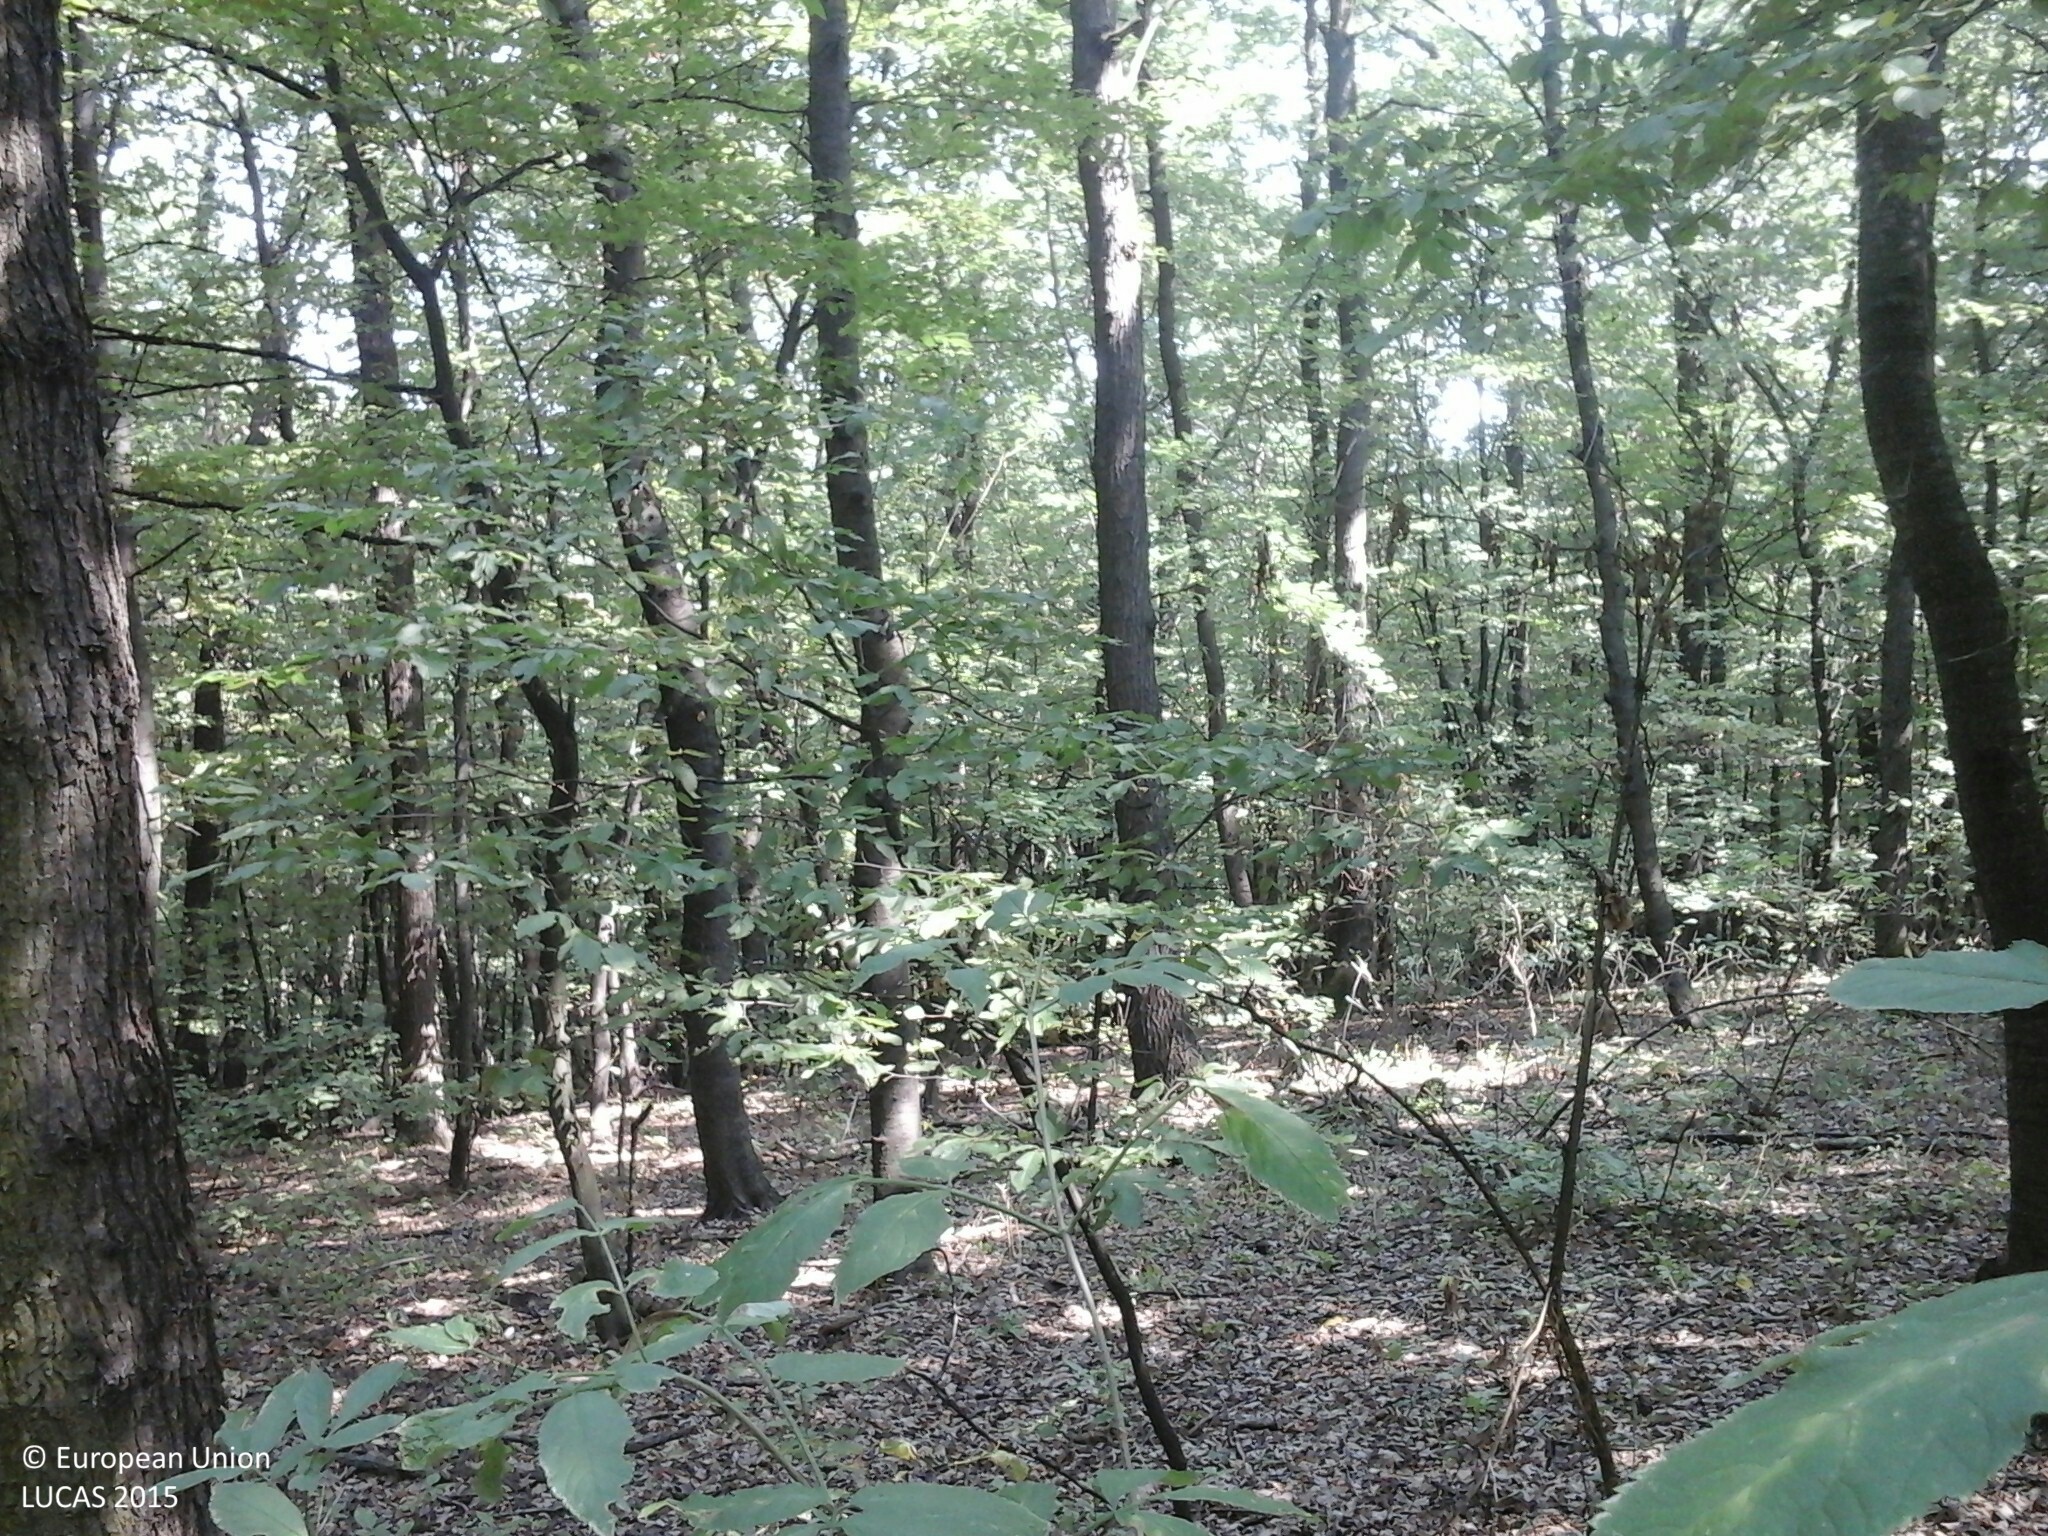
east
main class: Woodland
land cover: Broadleaved woodland
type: acidophilous oak and oak-birch forest
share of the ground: > 75 %
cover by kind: broadleaved forest trees 90 %, shrubs 10 %
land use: Forestry
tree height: > 5 m
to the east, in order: Broadleaved woodland
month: August
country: HU
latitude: 48.1376
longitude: 20.6923
